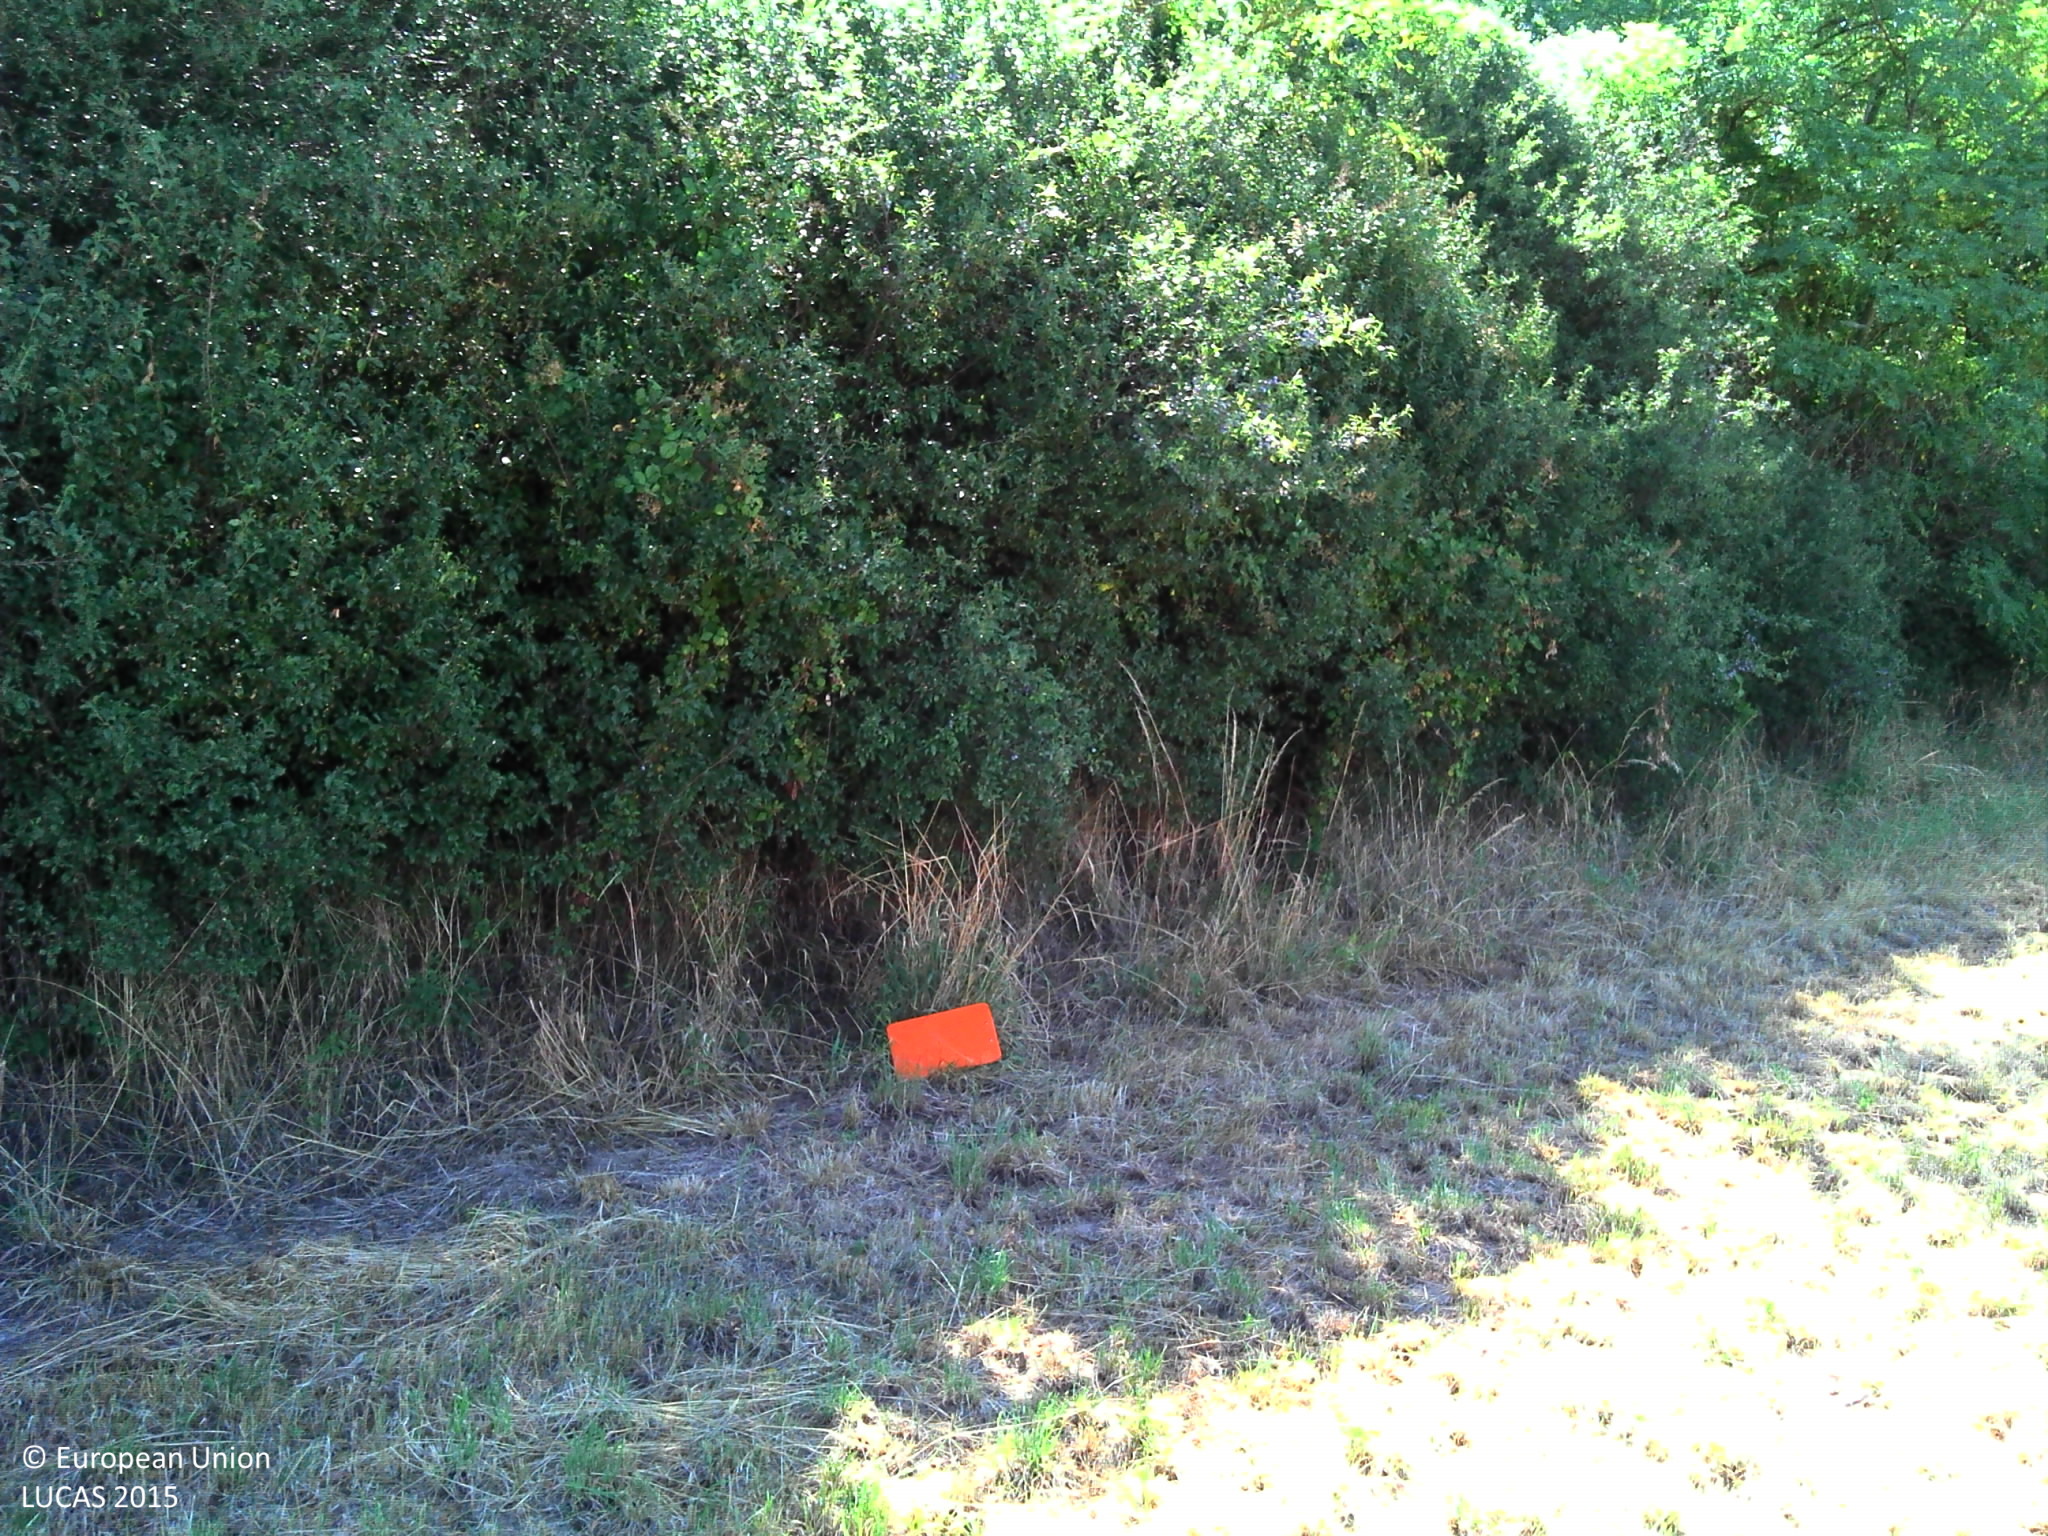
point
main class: Woodland
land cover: Broadleaved woodland
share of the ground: > 75 %
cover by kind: broadleaved forest trees 85 %, shrubs 5 %, herbaceous plants 5 %, lichens and mosses 5 %
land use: Semi-natural and natural areas not in use
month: July
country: FR
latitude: 45.5589
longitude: 4.1484
